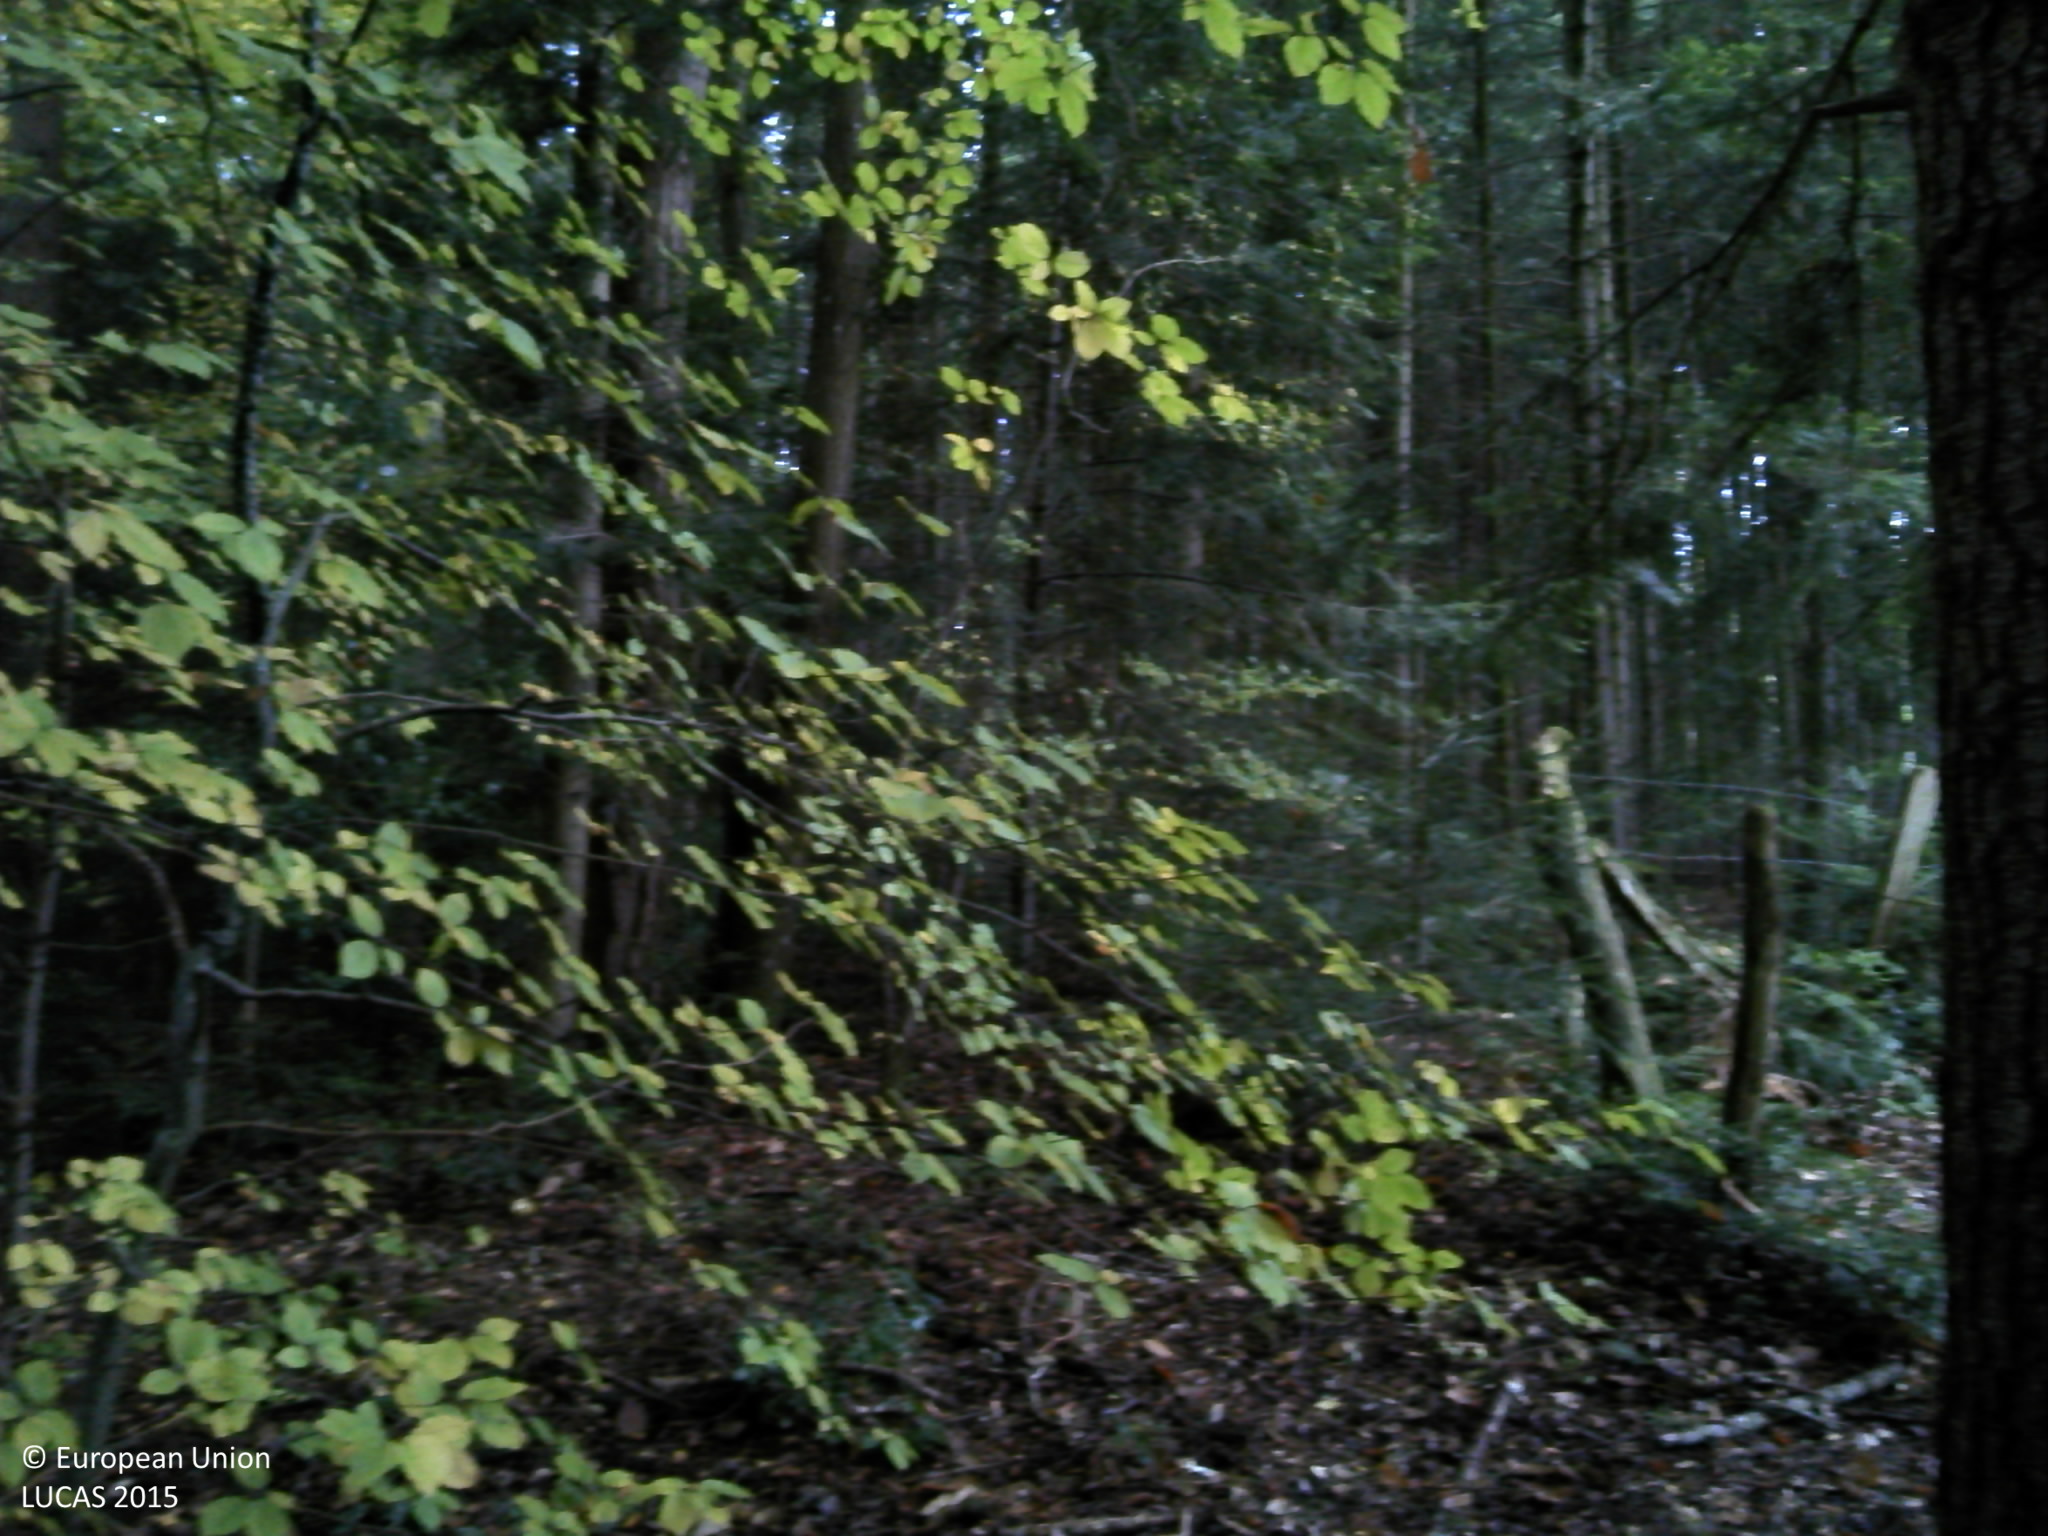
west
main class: Woodland
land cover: Spruce dominated mixed woodland
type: acidophilous oak and oak-birch forest
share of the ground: > 75 %
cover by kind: coniferous forest trees 60 %, broadleaved forest trees 30 %, unconsolidated bare surface 10 %
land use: Forestry
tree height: > 5 m
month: October
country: FR
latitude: 45.6596
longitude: 3.7004
